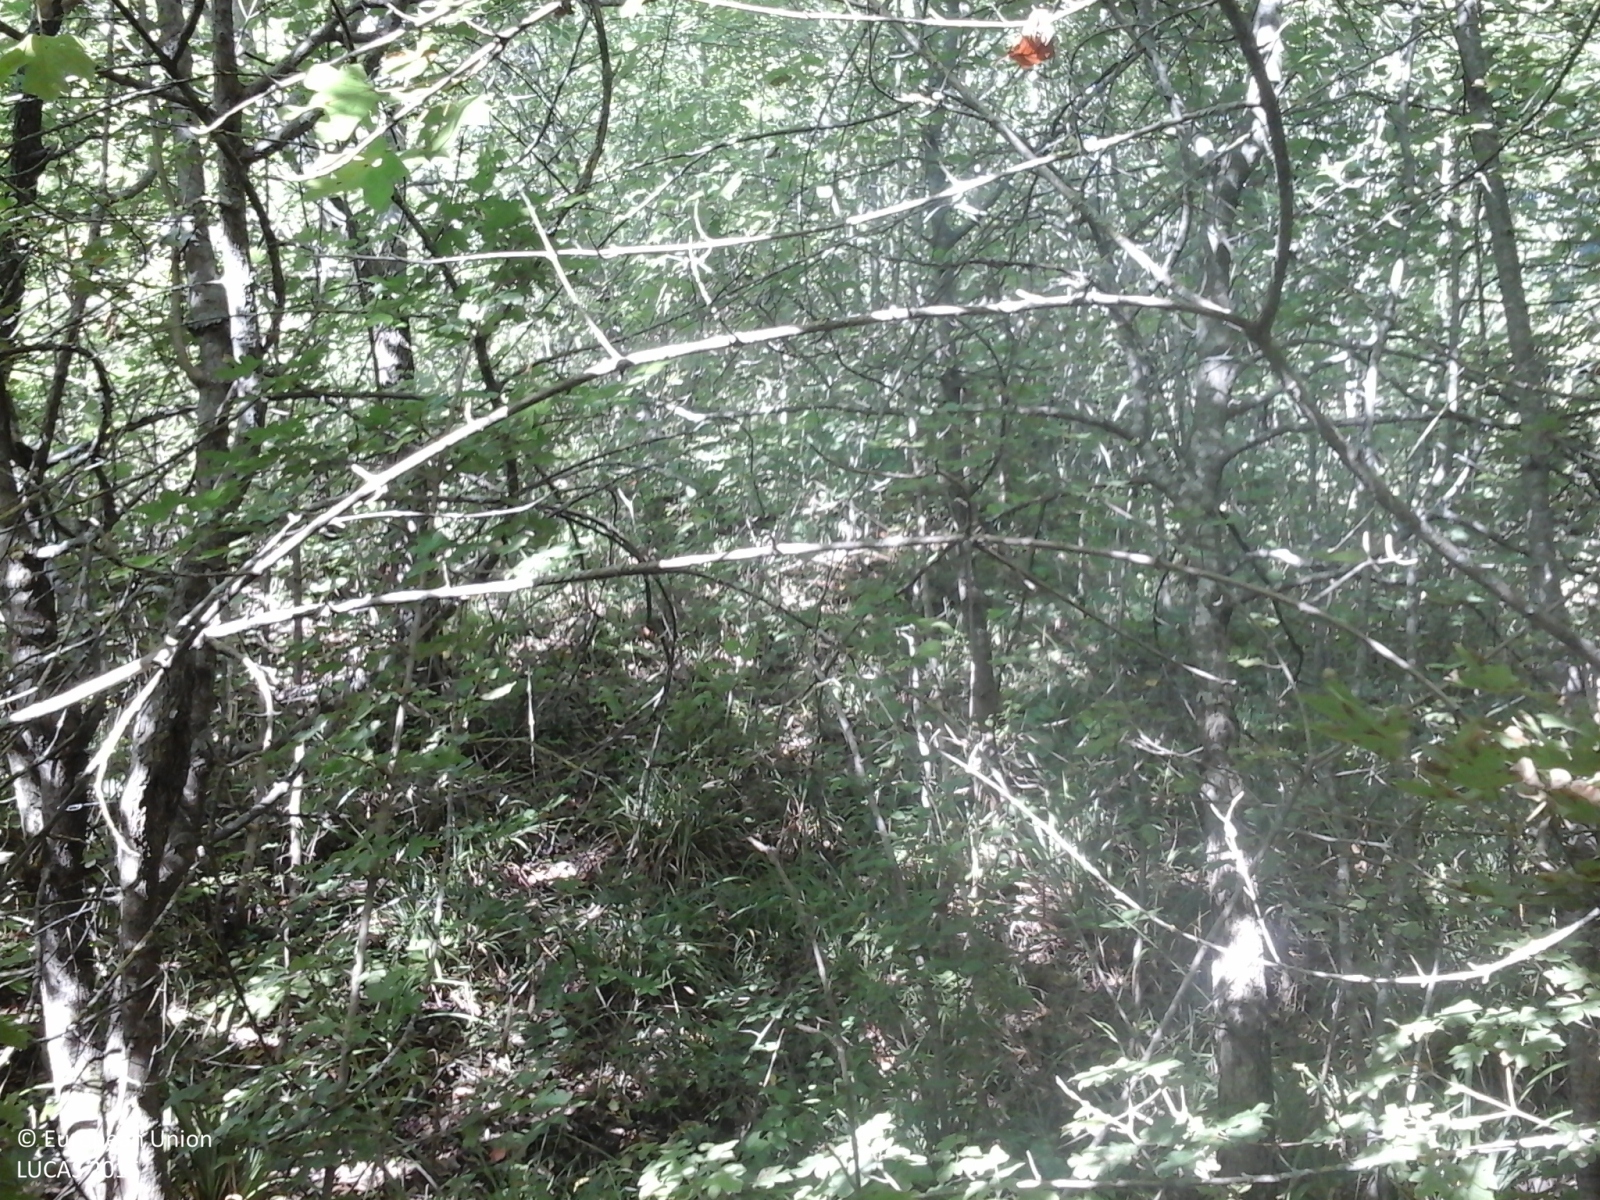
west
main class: Woodland
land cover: Broadleaved woodland
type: thermophilous deciduous forest
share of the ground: > 75 %
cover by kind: broadleaved forest trees 95 %, shrubs 5 %
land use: Forestry
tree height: > 5 m
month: August
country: IT
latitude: 43.1064
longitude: 13.2965
